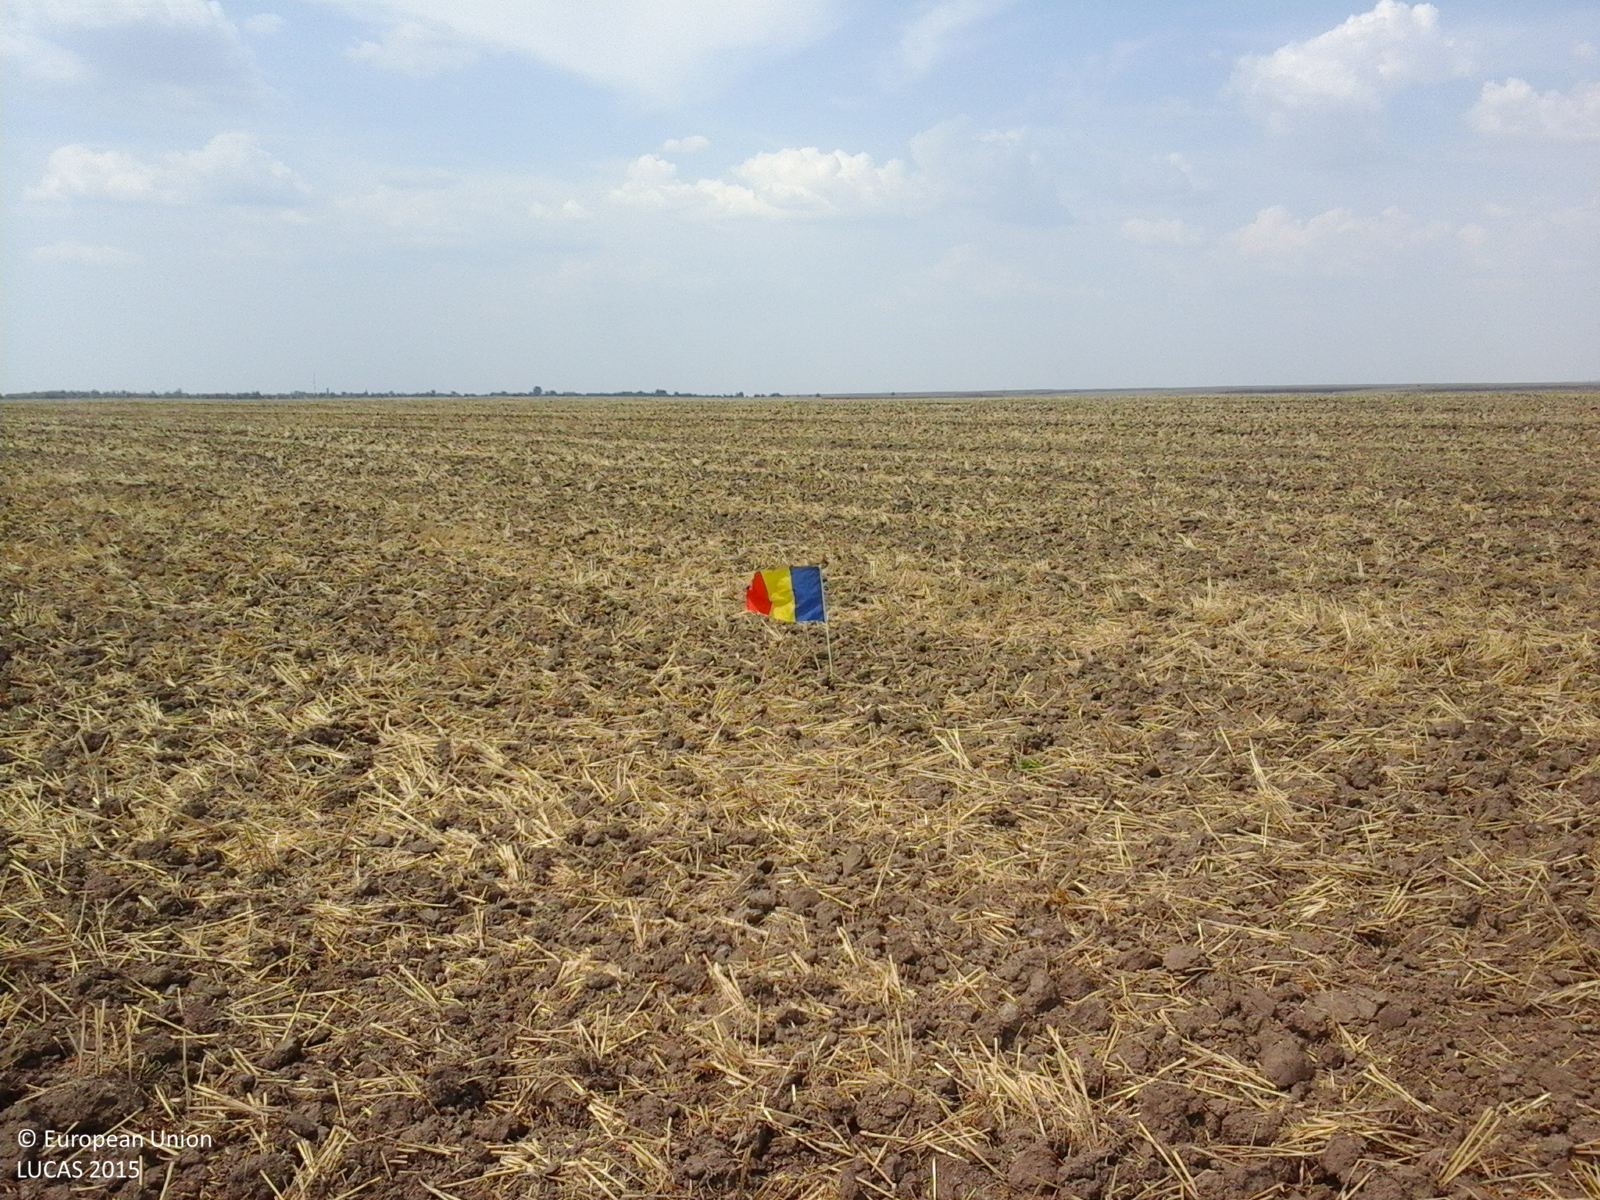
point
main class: Cropland
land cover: Common wheat
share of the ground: 25 - 50 %
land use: Agriculture (excluding fallow land and kitchen gardens)
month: August
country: RO
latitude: 44.1536
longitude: 23.1102
